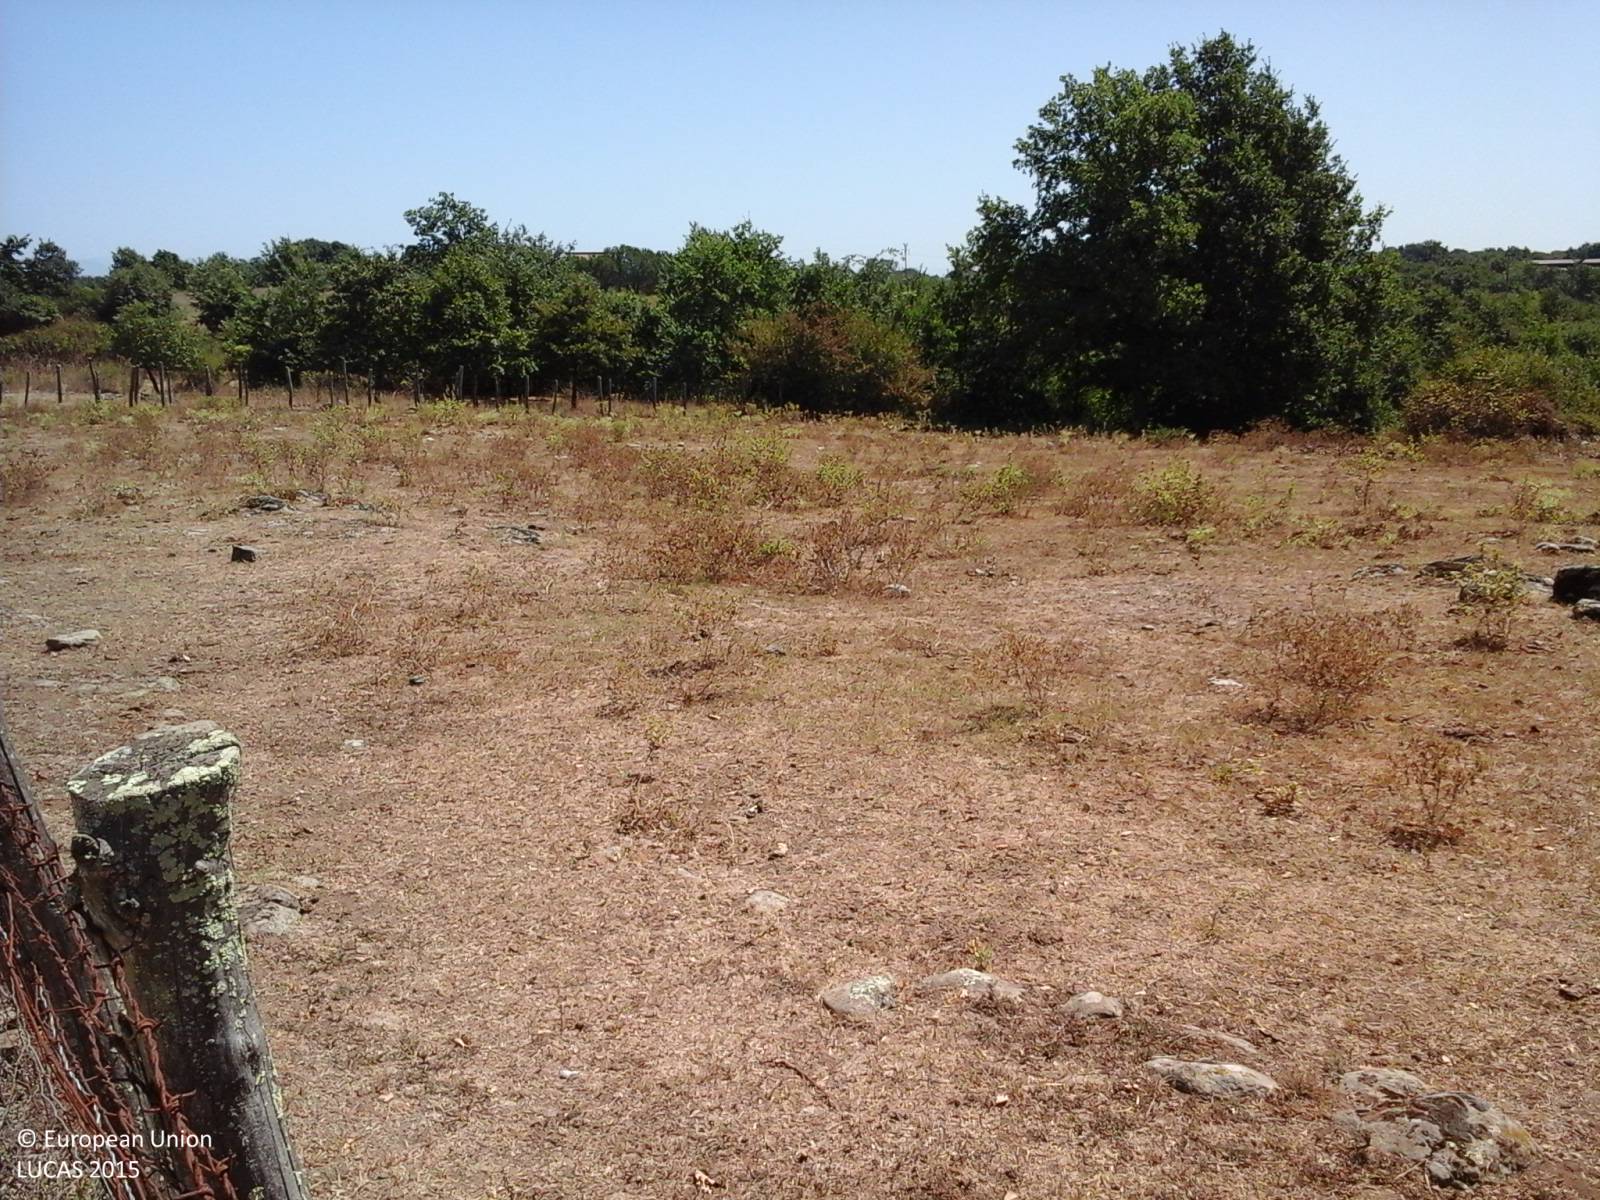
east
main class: Grassland
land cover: Grassland with sparse tree/shrub cover
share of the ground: > 75 %
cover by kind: herbaceous plants 60 %, unconsolidated bare surface 35 %, broadleaved forest trees 5 %
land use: Agriculture (excluding fallow land and kitchen gardens)
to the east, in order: Grassland with sparse tree/shrub cover; Single bushes/trees; Fences; Managed hedges; Grassland with sparse tree/shrub cover; Tracks; Broadleaved woodland; Grassland without tree/shrub cover; Electric lines; Grassland without tree/shrub cover; Broadleaved woodland; Tracks; Broadleaved woodland
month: July
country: IT
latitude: 42.2116
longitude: 12.3296
